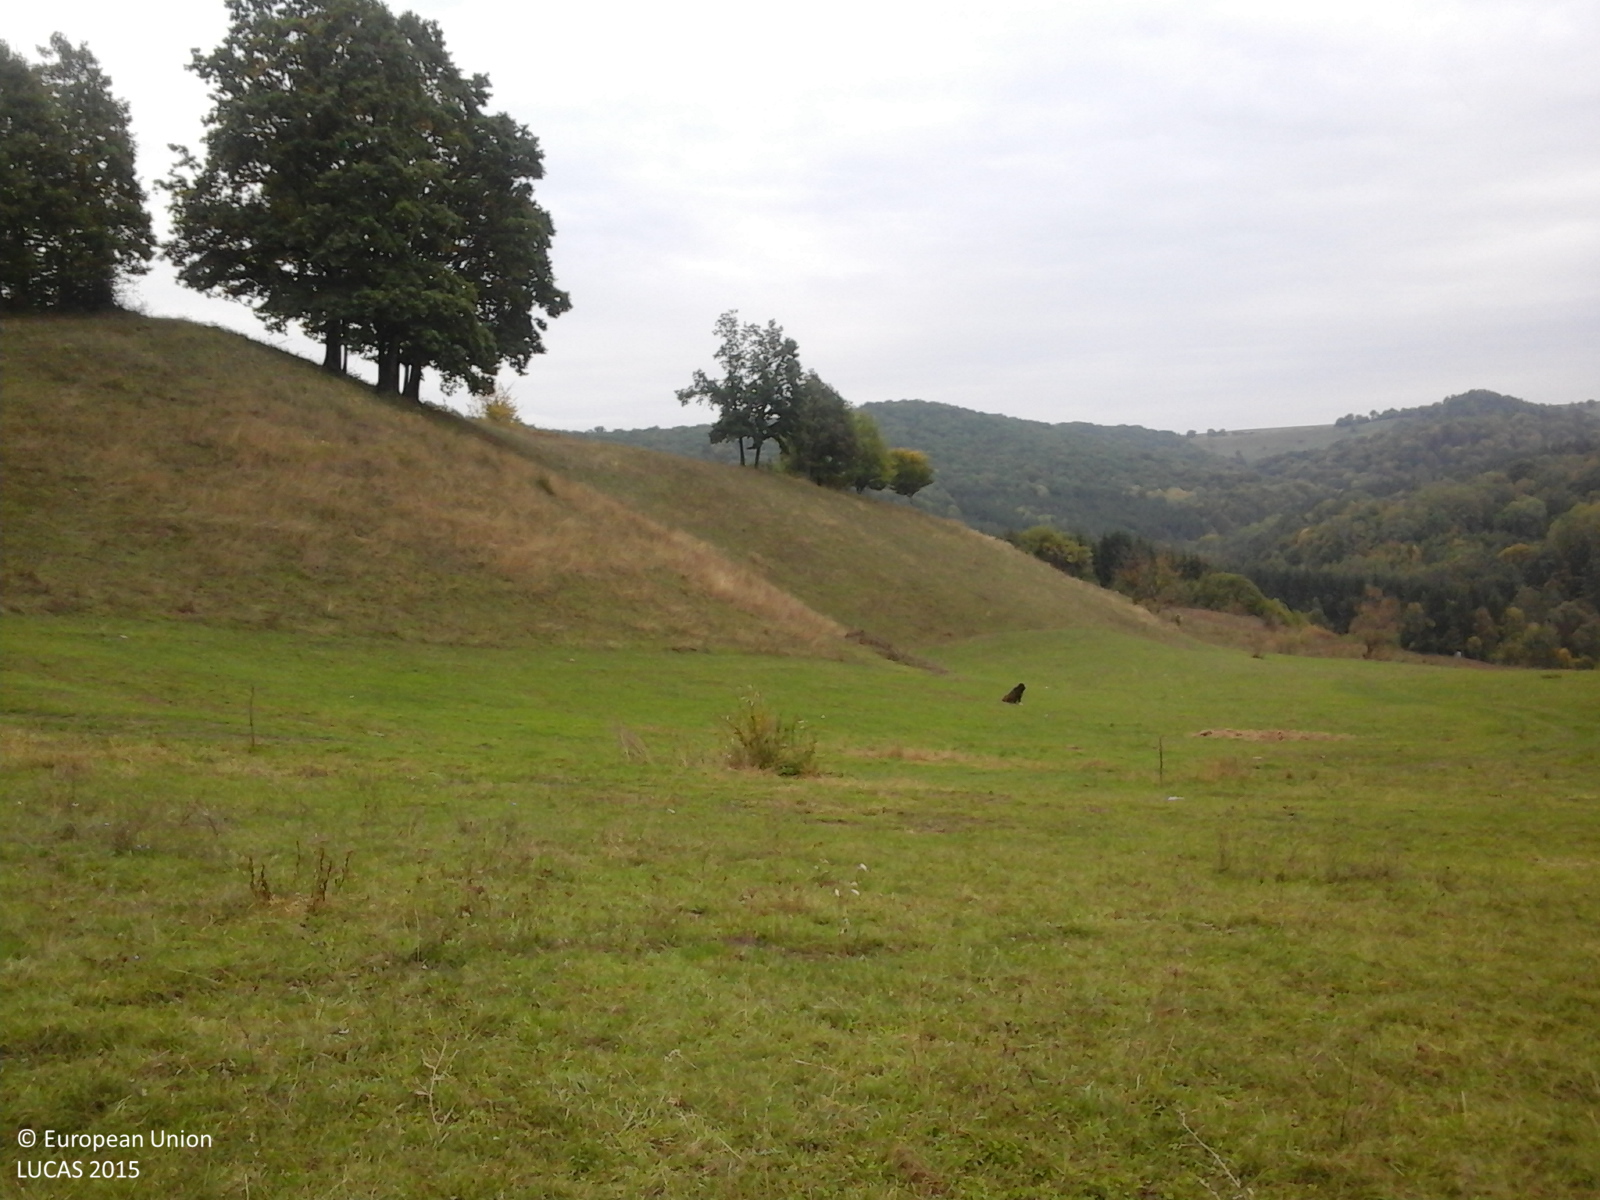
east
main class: Grassland
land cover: Grassland without tree/shrub cover
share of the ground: > 75 %
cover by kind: herbaceous plants 100 %
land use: Agriculture (excluding fallow land and kitchen gardens)
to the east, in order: Grassland without tree/shrub cover; Grassland with sparse tree/shrub cover; Grassland without tree/shrub cover; Broadleaved woodland; Grassland with sparse tree/shrub cover
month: October
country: RO
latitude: 46.8448
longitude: 24.8490
